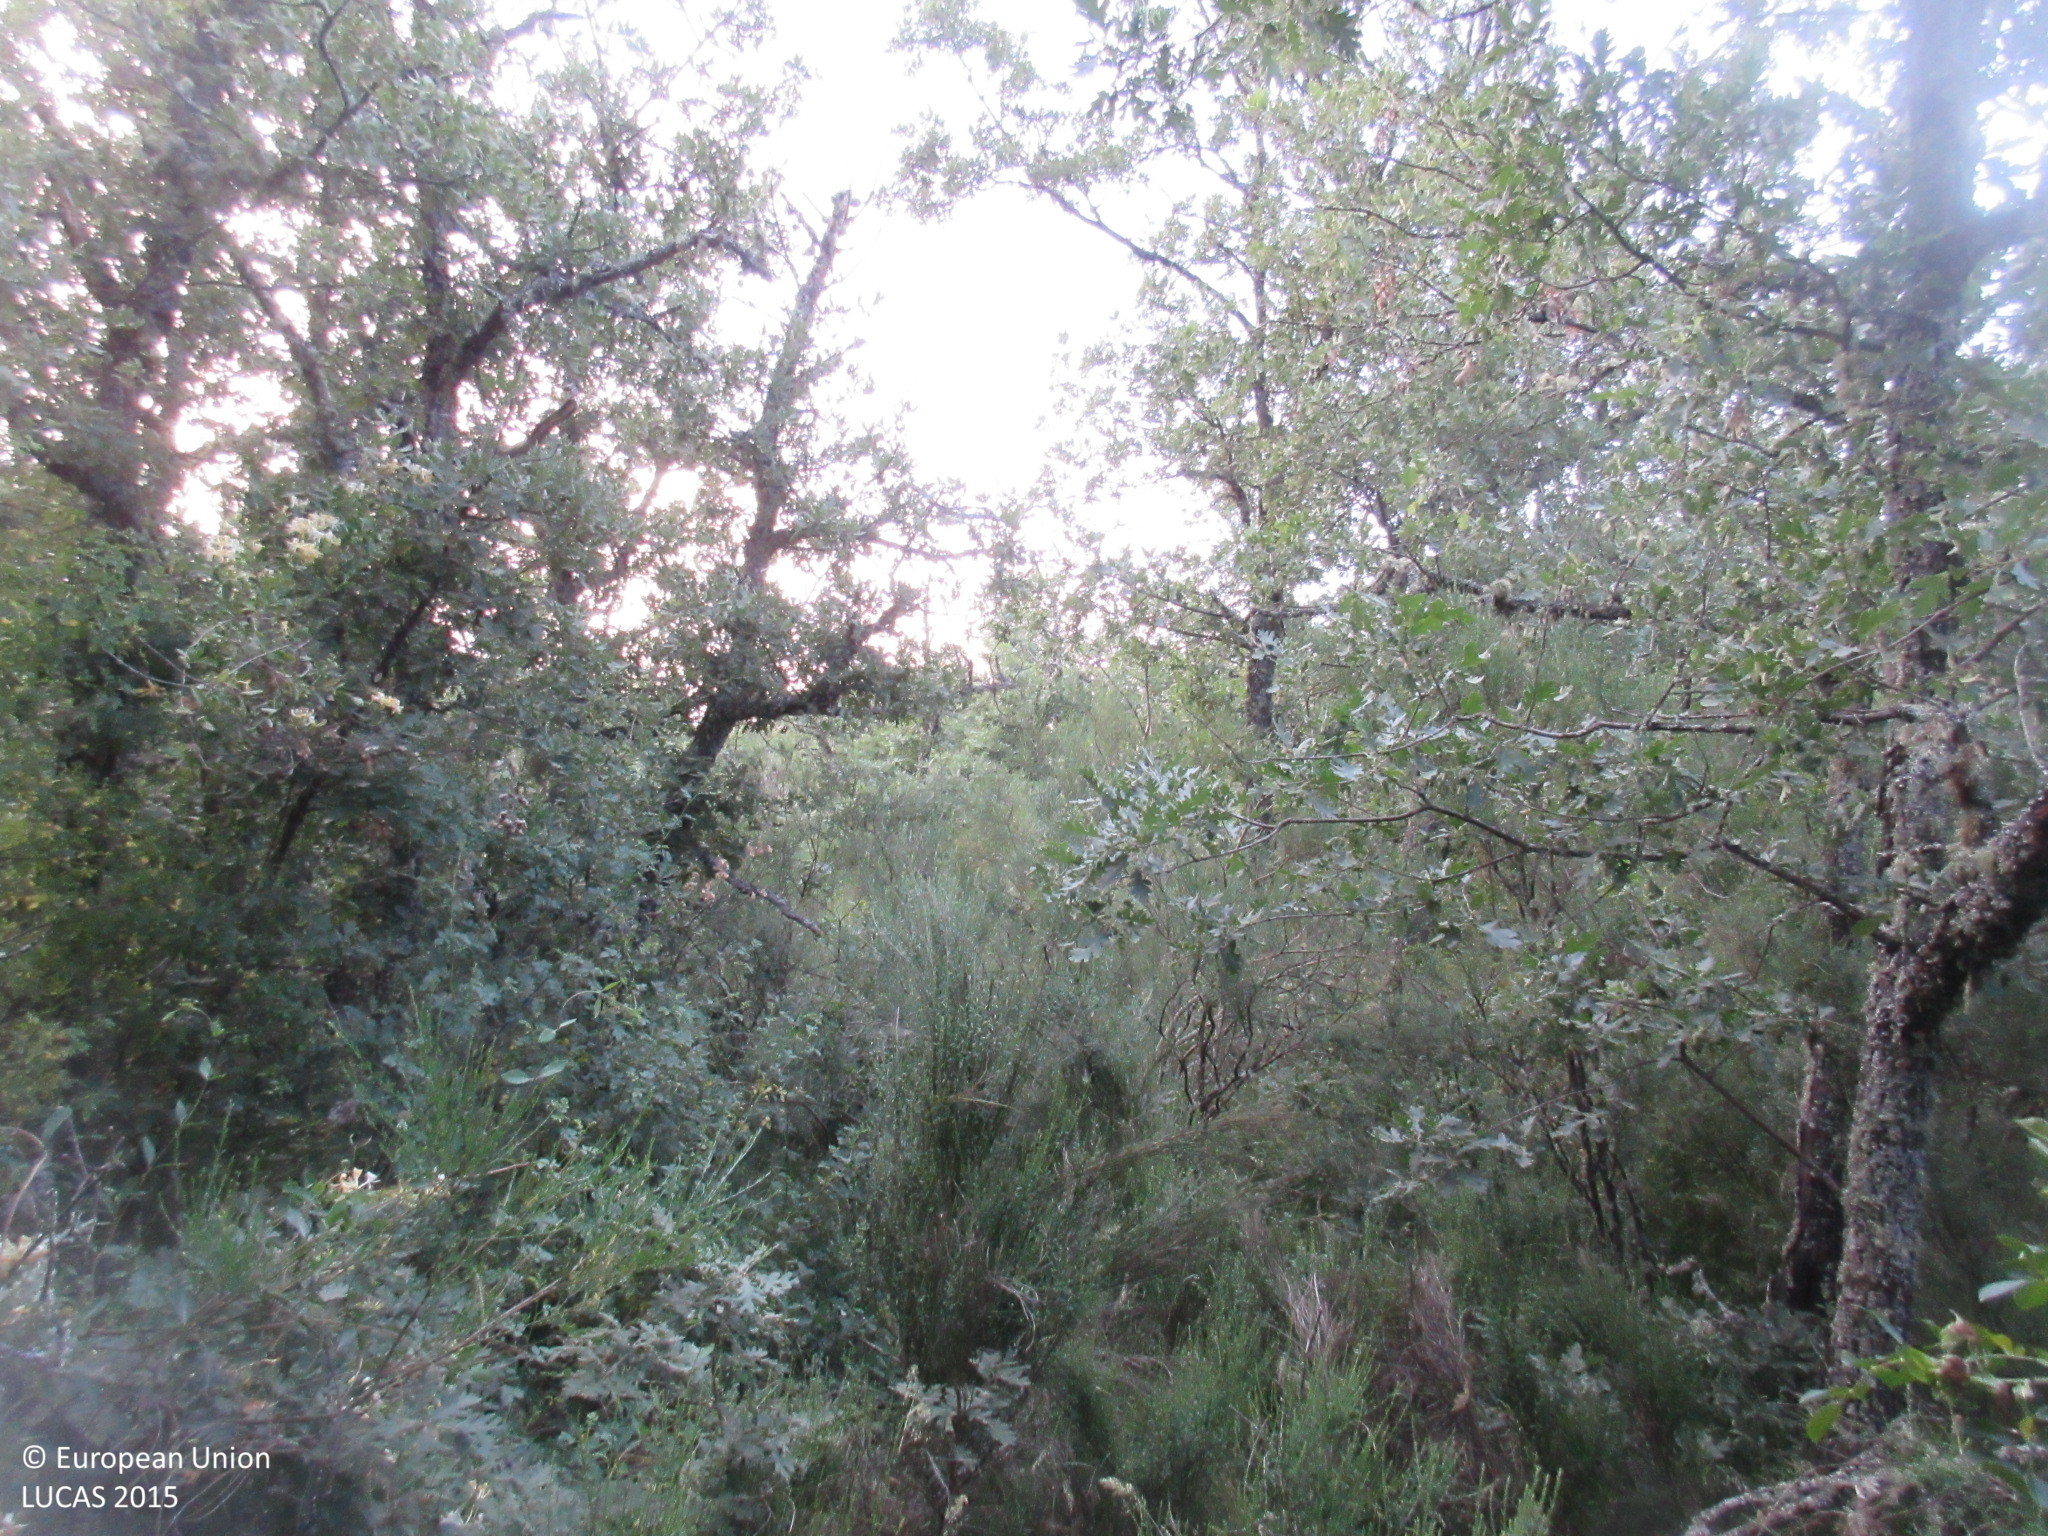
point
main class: Woodland
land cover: Broadleaved woodland
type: acidophilous oak and oak-birch forest
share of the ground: > 75 %
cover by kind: broadleaved forest trees 90 %, shrubs 10 %
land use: Semi-natural and natural areas not in use
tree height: > 5 m
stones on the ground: 10 - 25 %
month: July
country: ES
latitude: 42.8769
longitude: -4.4388
